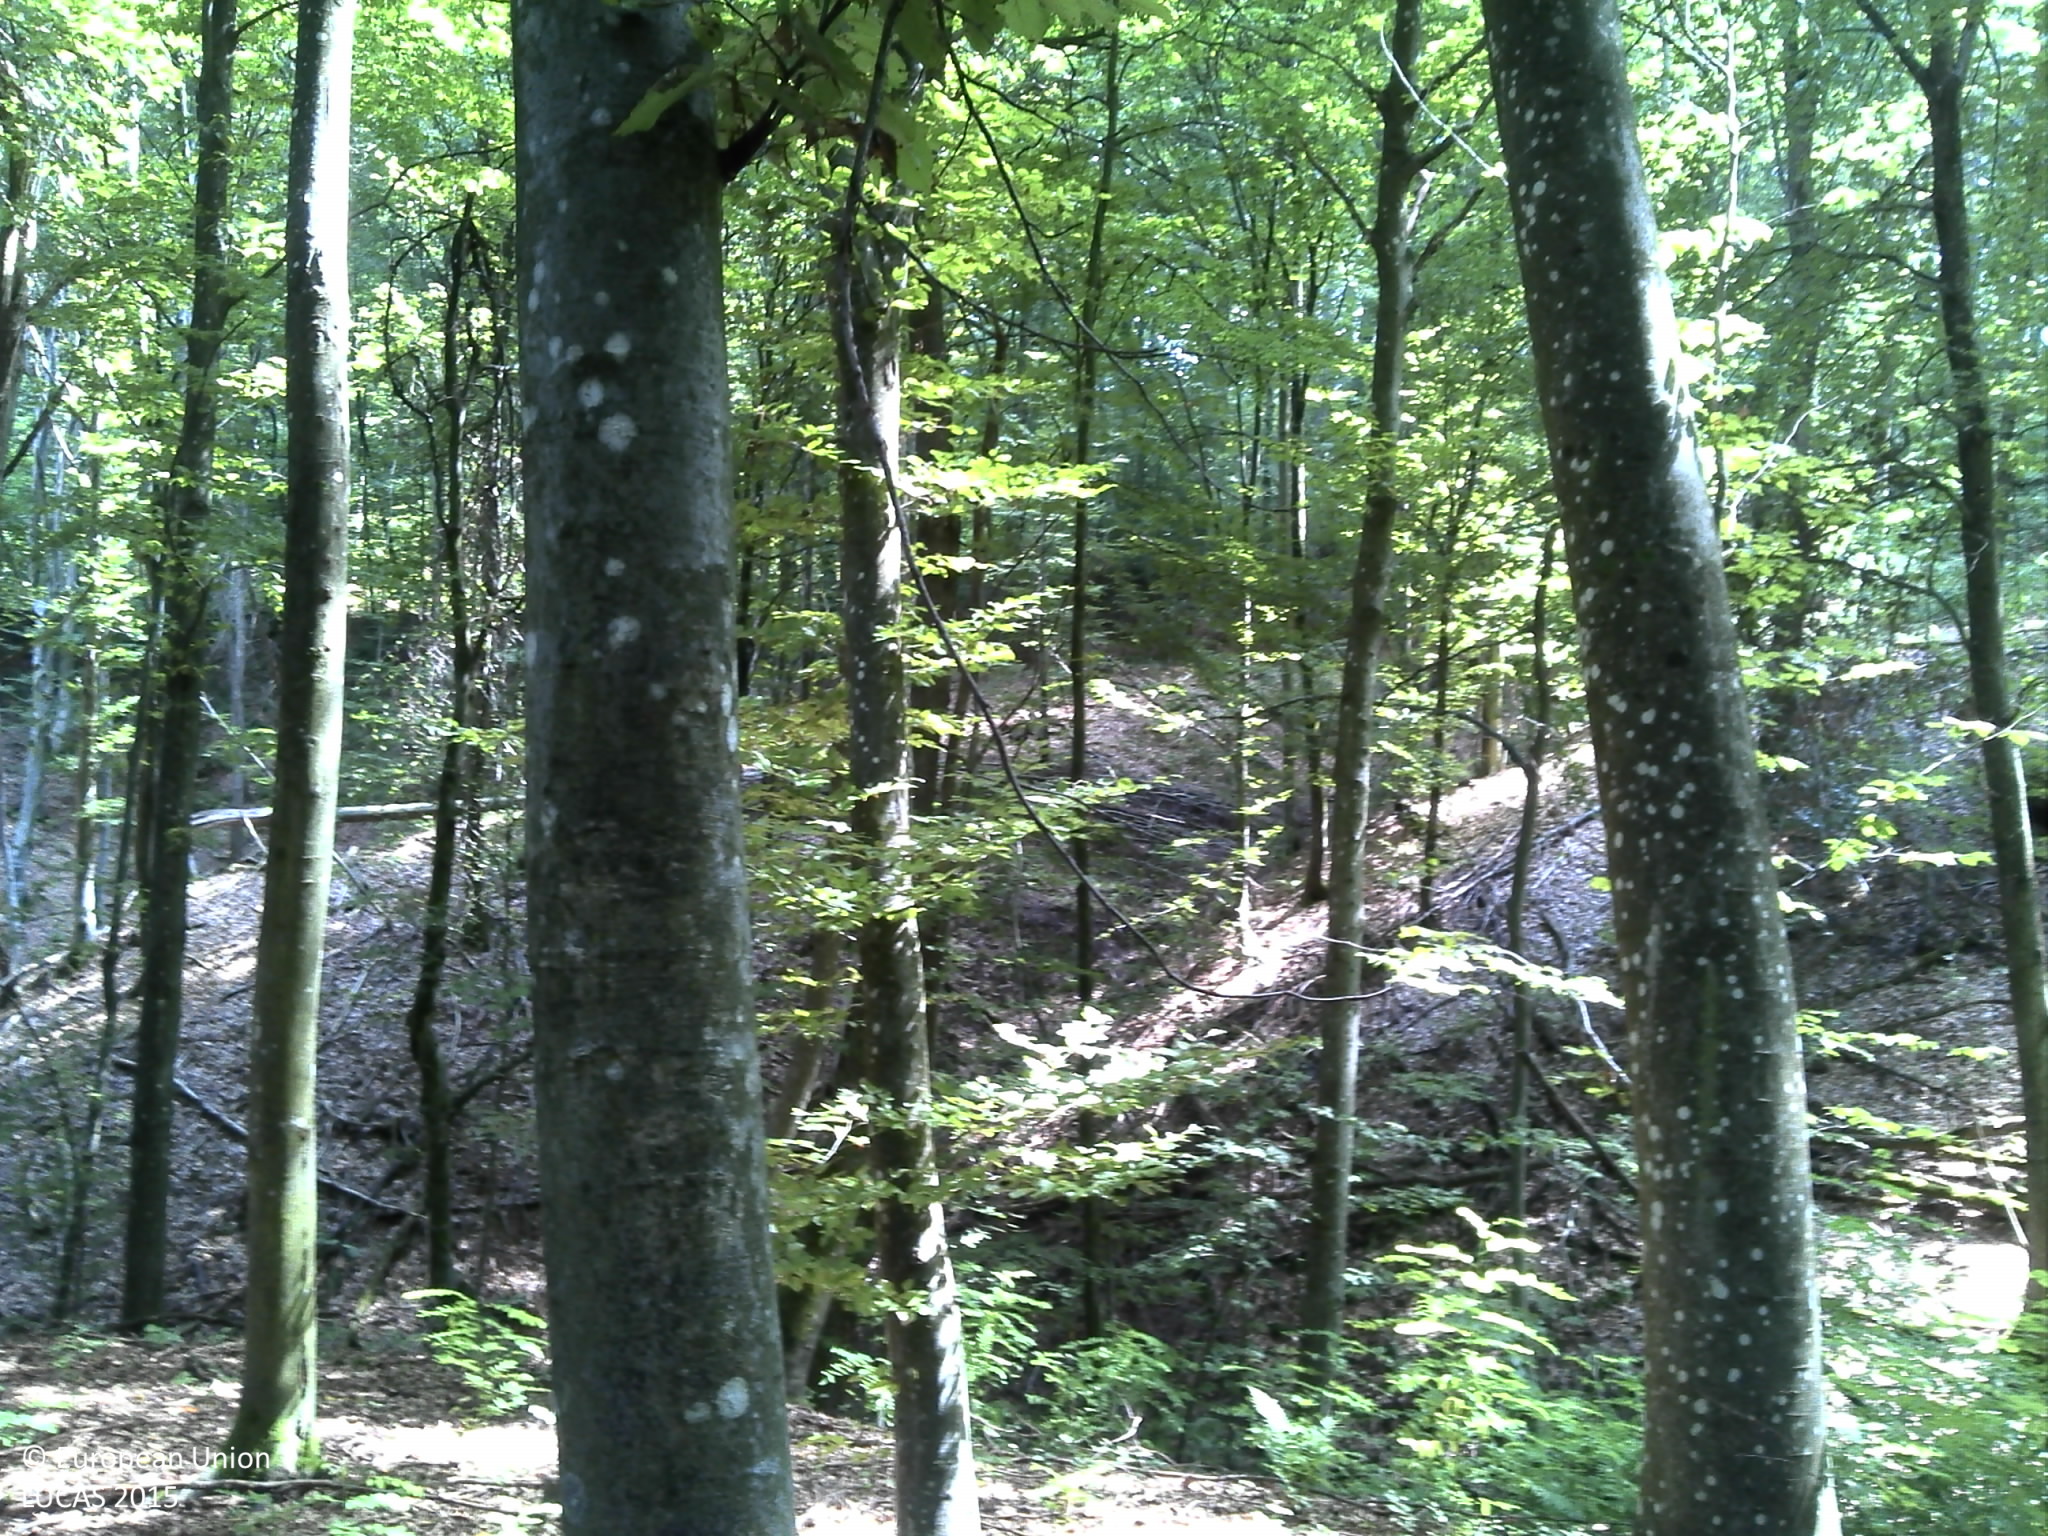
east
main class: Woodland
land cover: Broadleaved woodland
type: beech forest
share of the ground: > 75 %
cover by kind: broadleaved forest trees 100 %
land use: Forestry
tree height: > 5 m
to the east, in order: Broadleaved woodland; Rivers and streams; Broadleaved woodland; Tracks; Broadleaved woodland; Paved roads, cycling and walking lanes; Broadleaved woodland
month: August
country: HR
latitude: 45.3462
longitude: 15.7778
